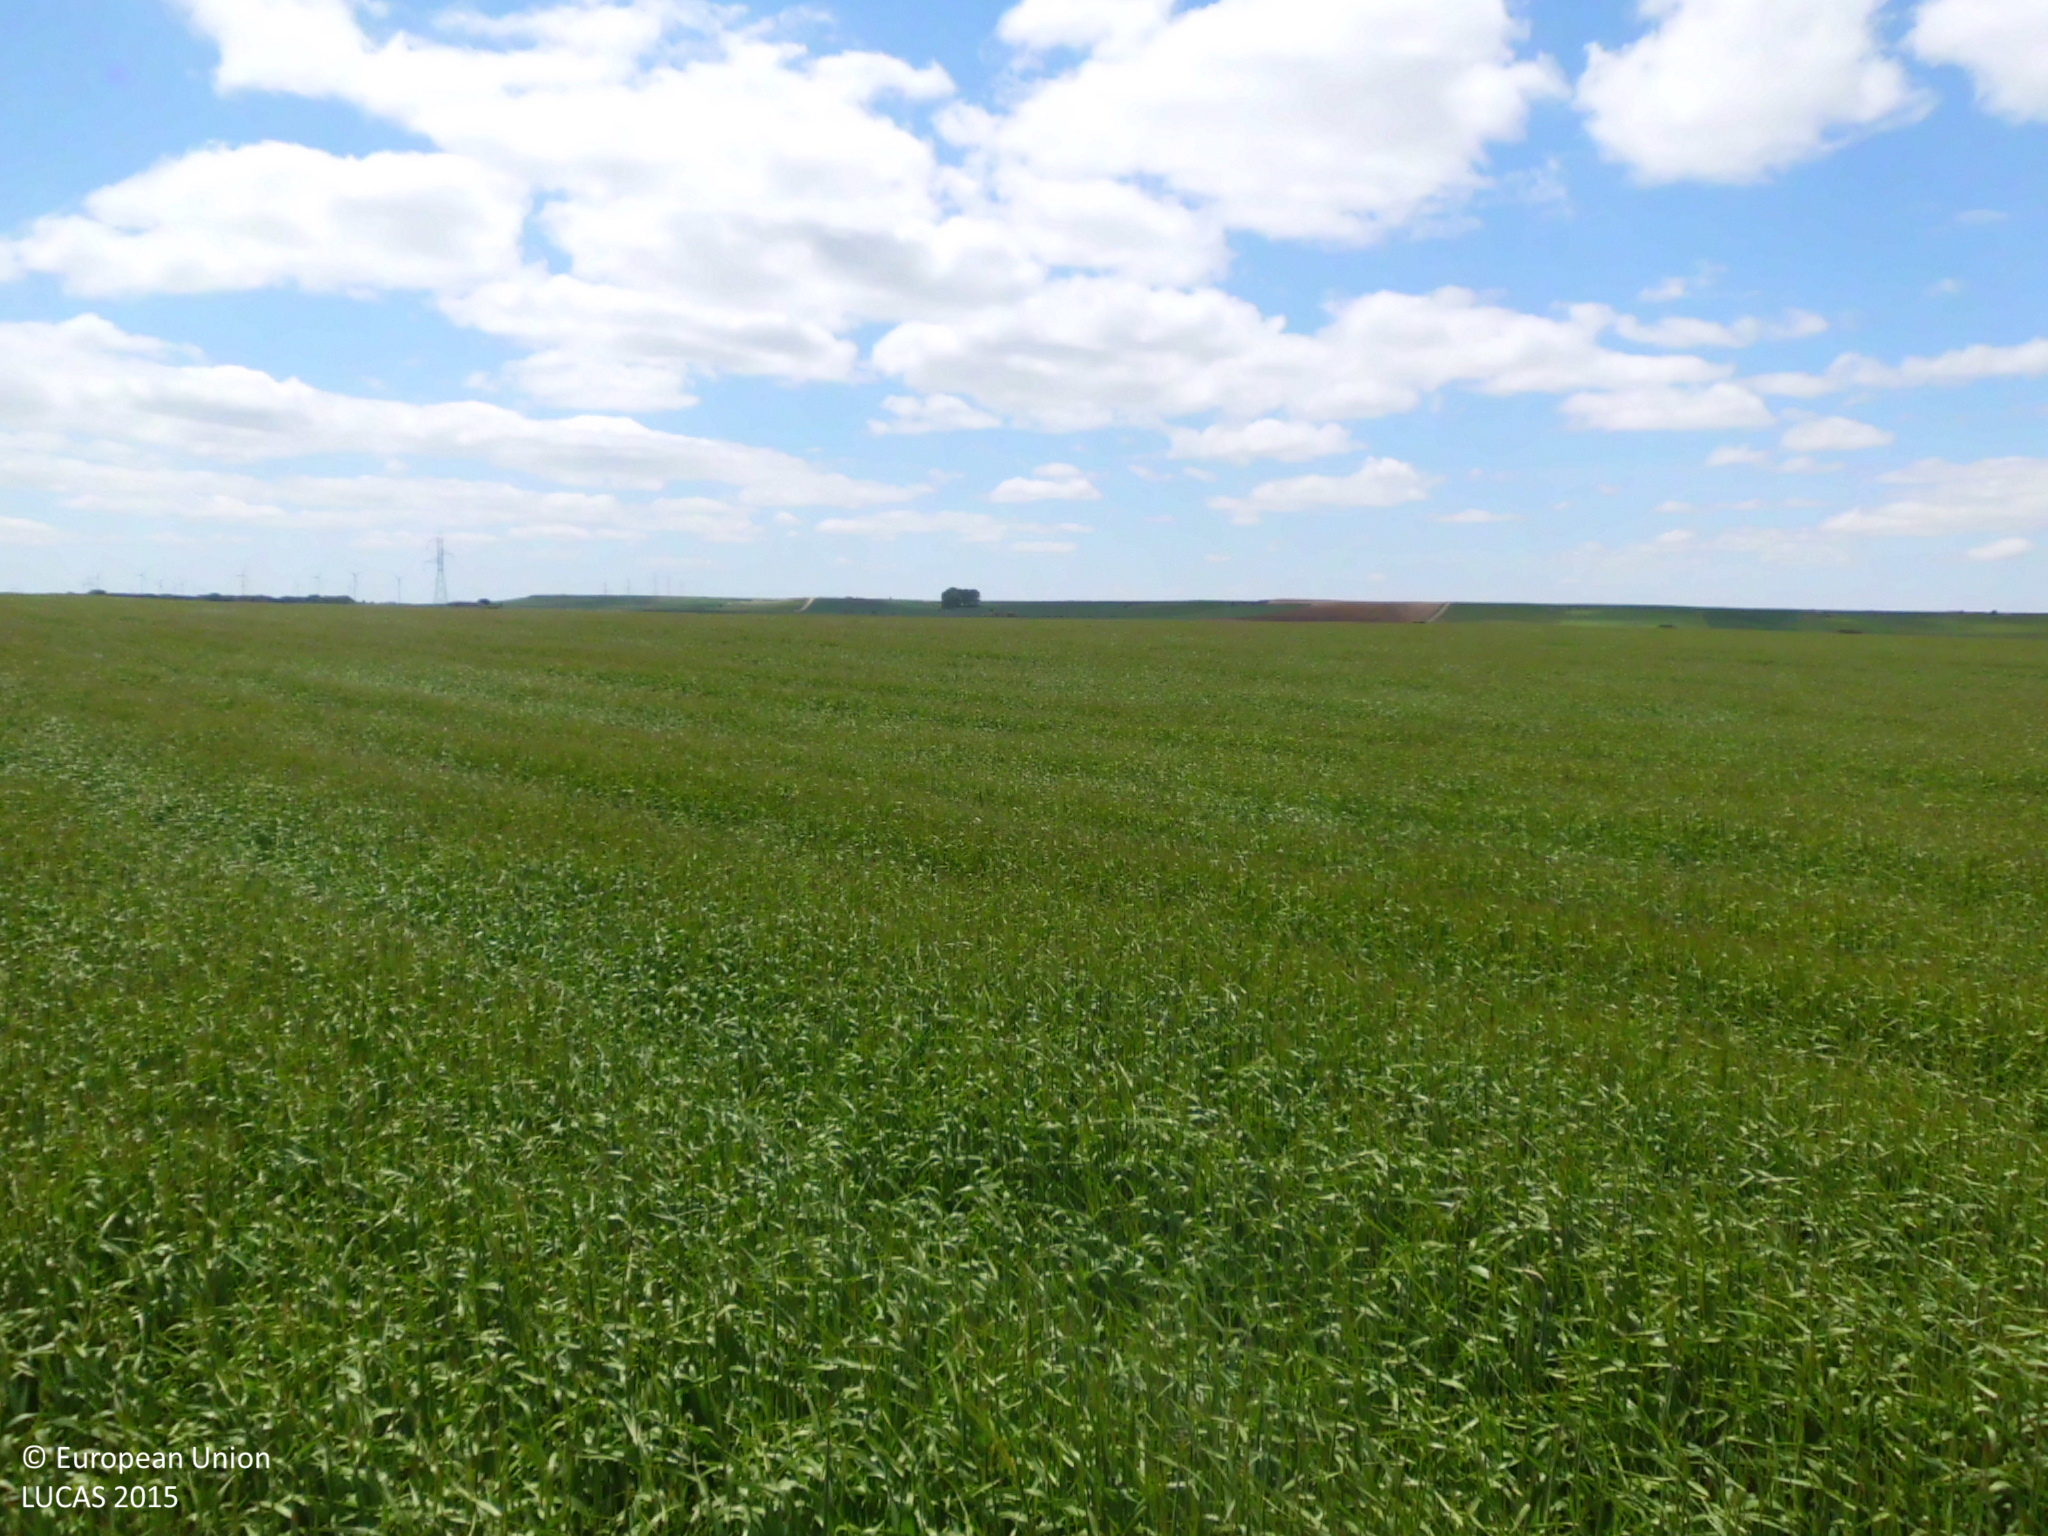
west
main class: Cropland
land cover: Barley
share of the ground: > 75 %
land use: Agriculture (excluding fallow land and kitchen gardens)
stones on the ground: 10 - 25 %
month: May
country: ES
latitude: 42.2983
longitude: -4.0017
